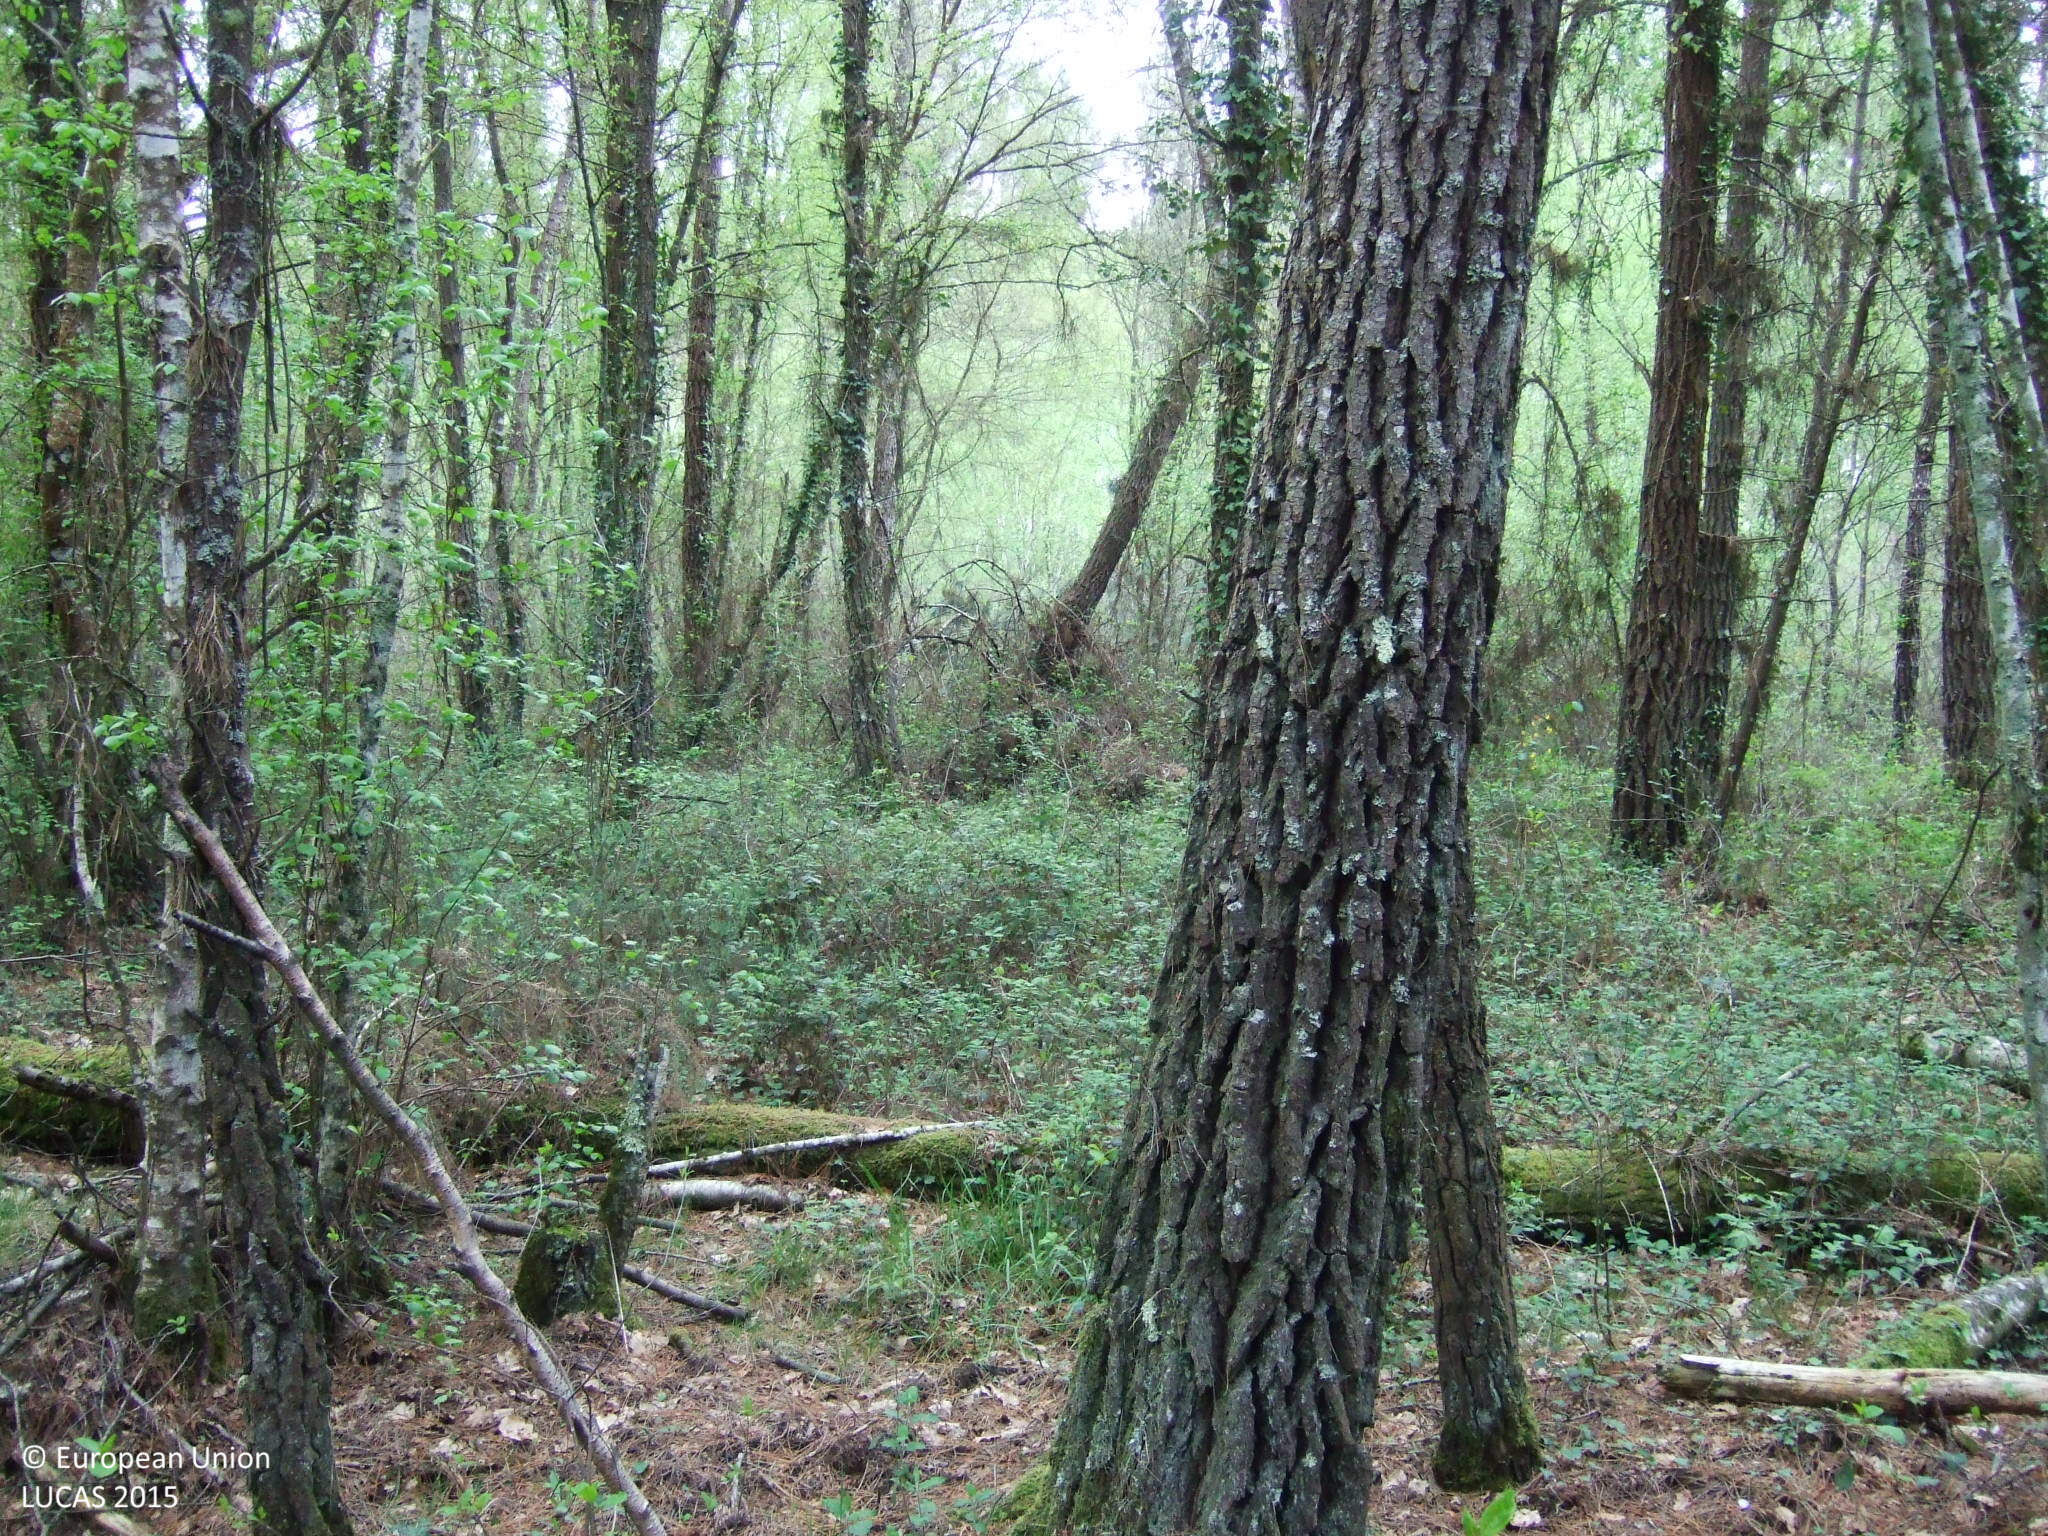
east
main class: Woodland
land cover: Other mixed woodland
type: acidophilous oak and oak-birch forest
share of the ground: > 75 %
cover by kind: broadleaved forest trees 50 %, coniferous forest trees 25 %, shrubs 25 %
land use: Forestry
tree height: > 5 m
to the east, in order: Other mixed woodland; Broadleaved woodland; Dry stone walls; Electric lines; Railways; Groves; Fences; Grassland without tree/shrub cover; Dry stone walls; Grassland without tree/shrub cover
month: April
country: ES
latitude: 43.1628
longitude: -7.7082
